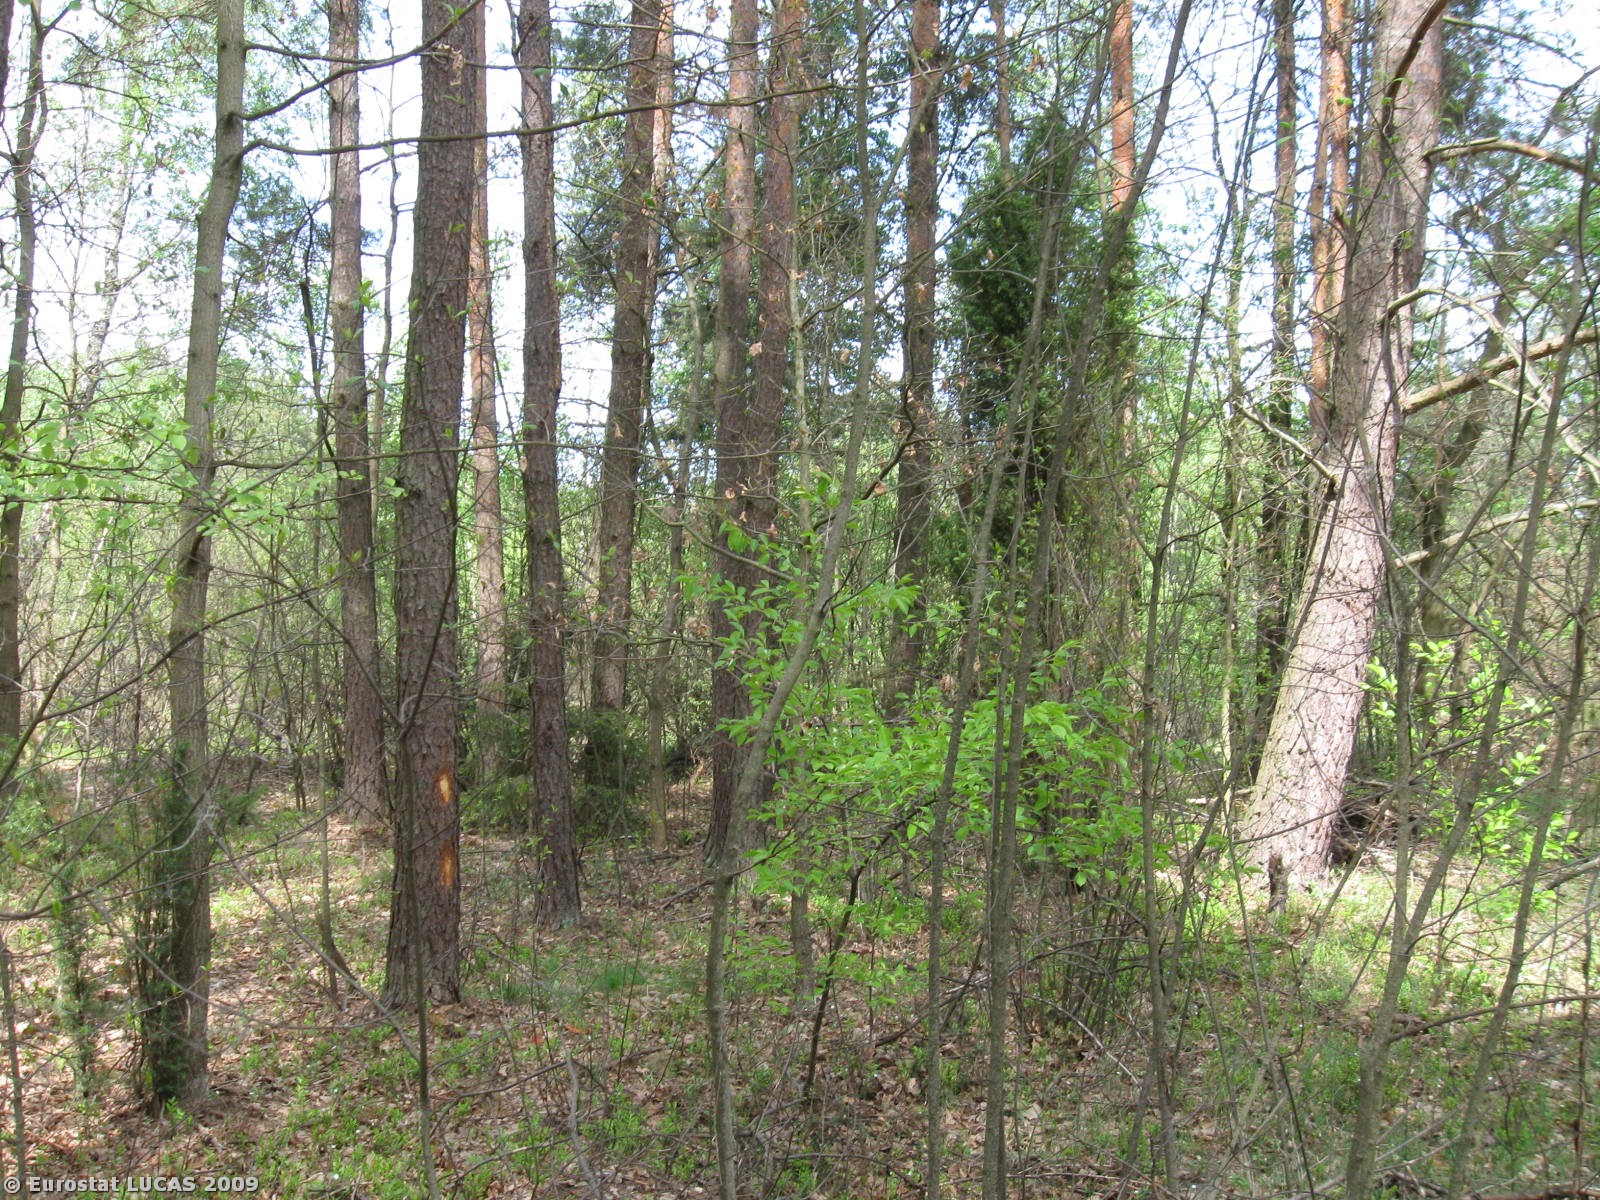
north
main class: Woodland
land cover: Mixed woodland
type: hemiboreal forest and nemoral coniferous forest and mixed broadleaved-coniferous forest
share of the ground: > 75 %
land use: Forestry
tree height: > 5 m
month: May
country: PL
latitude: 51.1651
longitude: 20.5210
